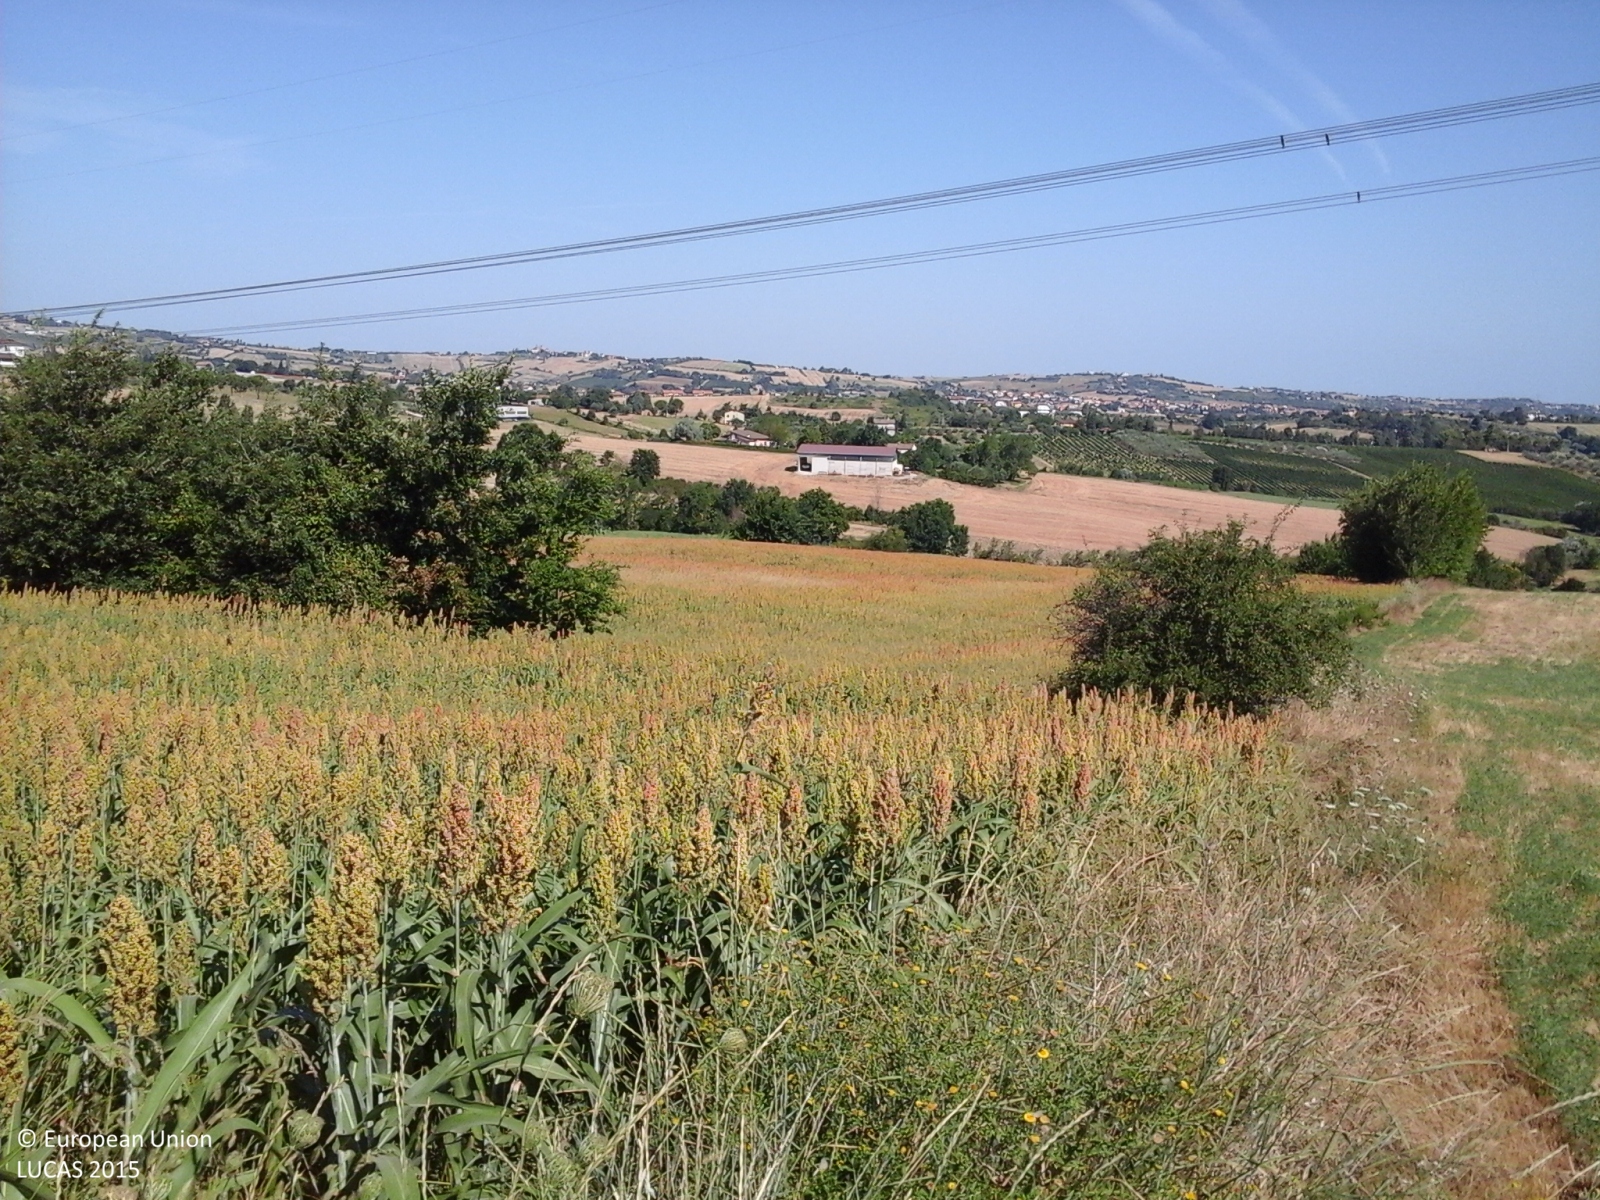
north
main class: Cropland
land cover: Other cereals
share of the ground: > 75 %
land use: Agriculture (excluding fallow land and kitchen gardens)
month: July
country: IT
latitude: 43.9011
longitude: 12.6705
